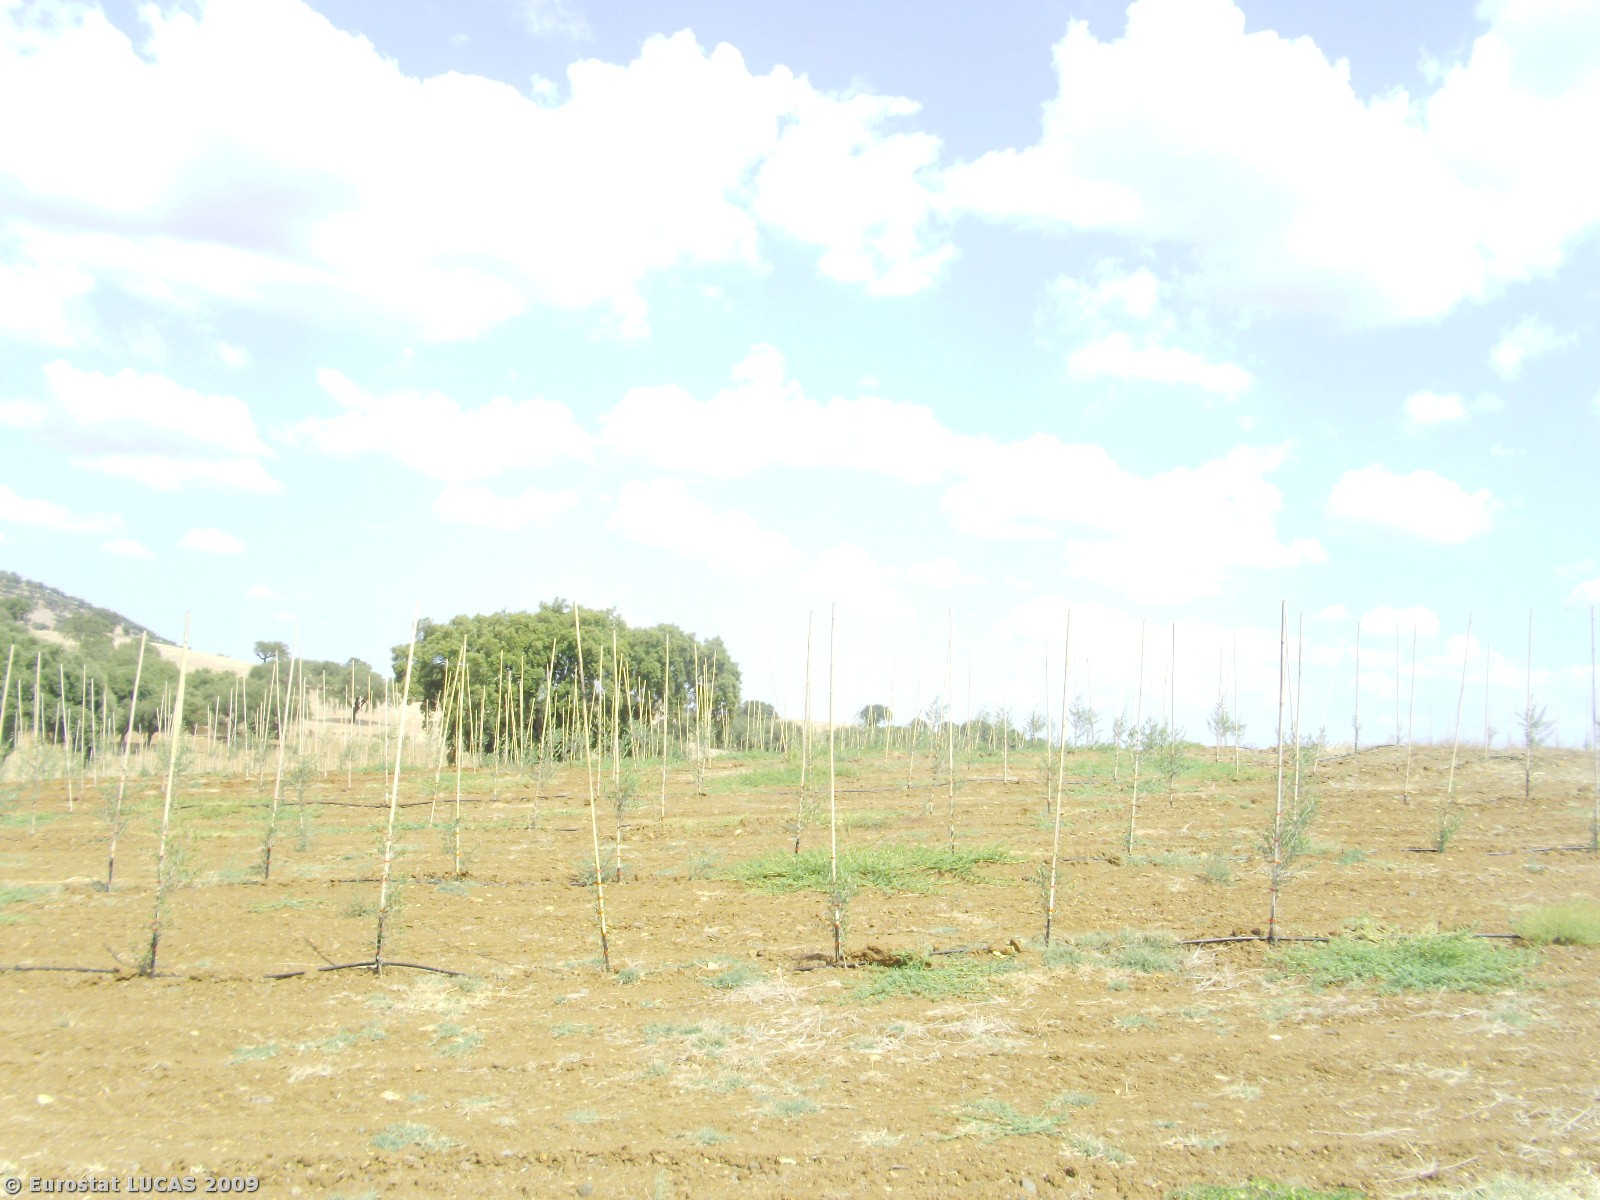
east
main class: Cropland
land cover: Olive groves
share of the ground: 50 - 75 %
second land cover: Spontaneously vegetated surfaces
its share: 50 - 75 %
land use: Agriculture (excluding fallow land and kitchen gardens)
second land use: Fallow land
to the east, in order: Olive groves; Spontaneously vegetated surfaces; Olive groves; Fences; Abandoned hedges; Common wheat; Abandoned hedges; Bare land; Fences; Grass margins; Tracks; Spontaneously vegetated surfaces
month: August
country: PT
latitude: 38.3436
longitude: -7.9187
